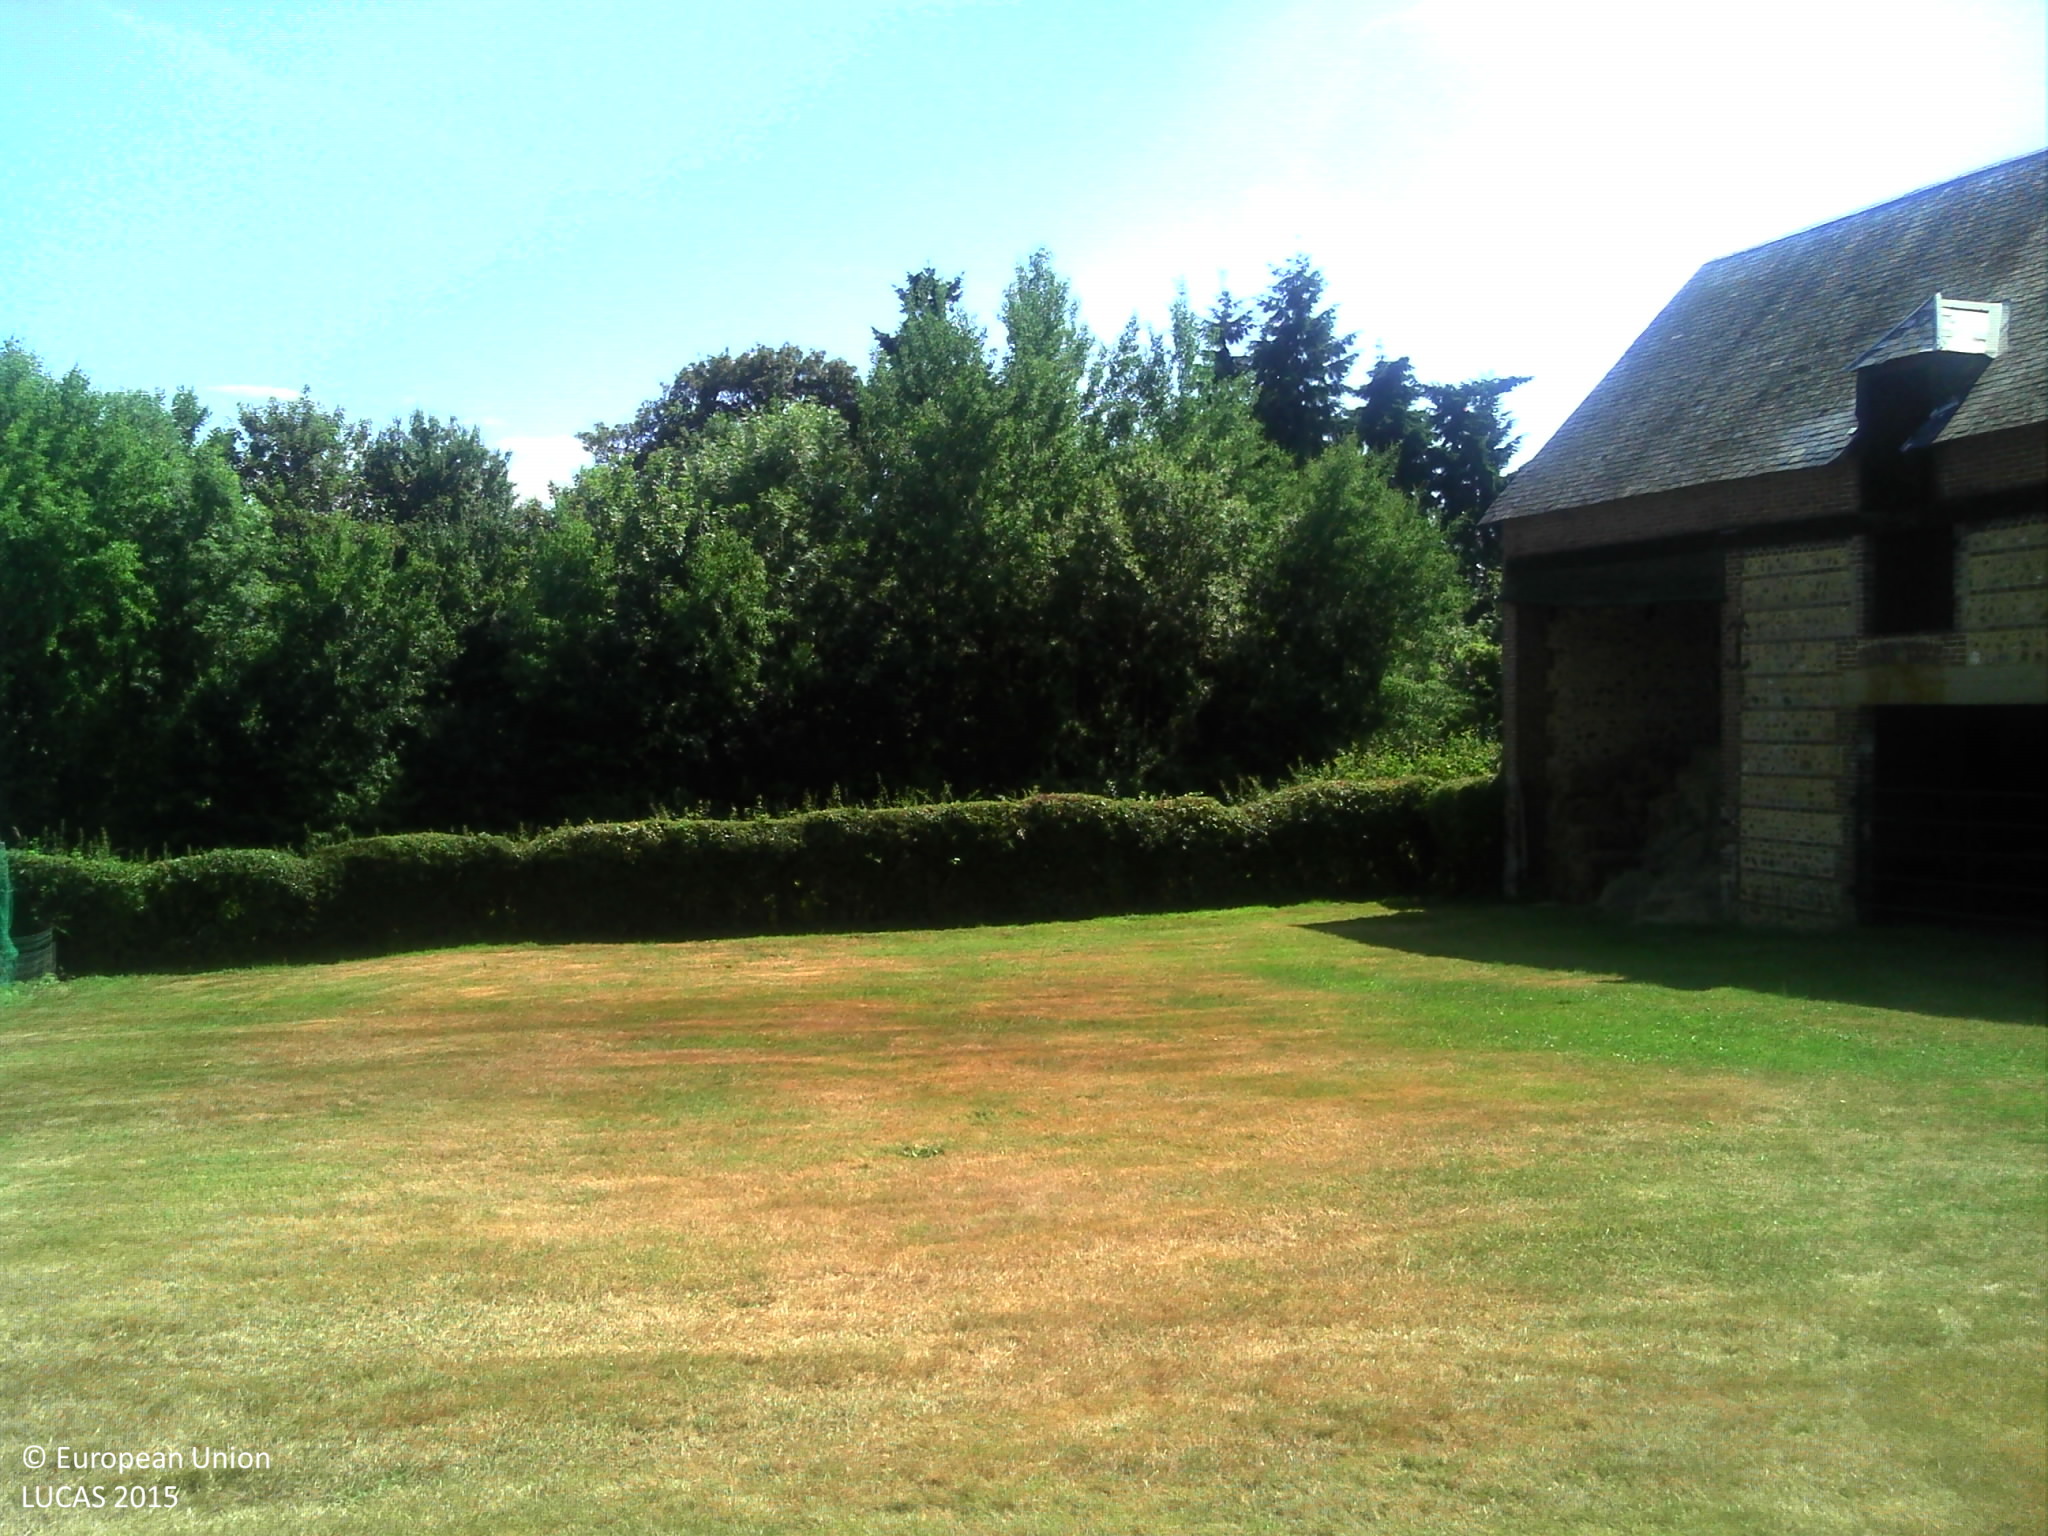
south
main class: Grassland
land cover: Grassland with sparse tree/shrub cover
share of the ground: > 75 %
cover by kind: herbaceous plants 90 %, coniferous forest trees 5 %, shrubs 5 %
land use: Residential
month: July
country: FR
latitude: 48.7361
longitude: 0.4975
